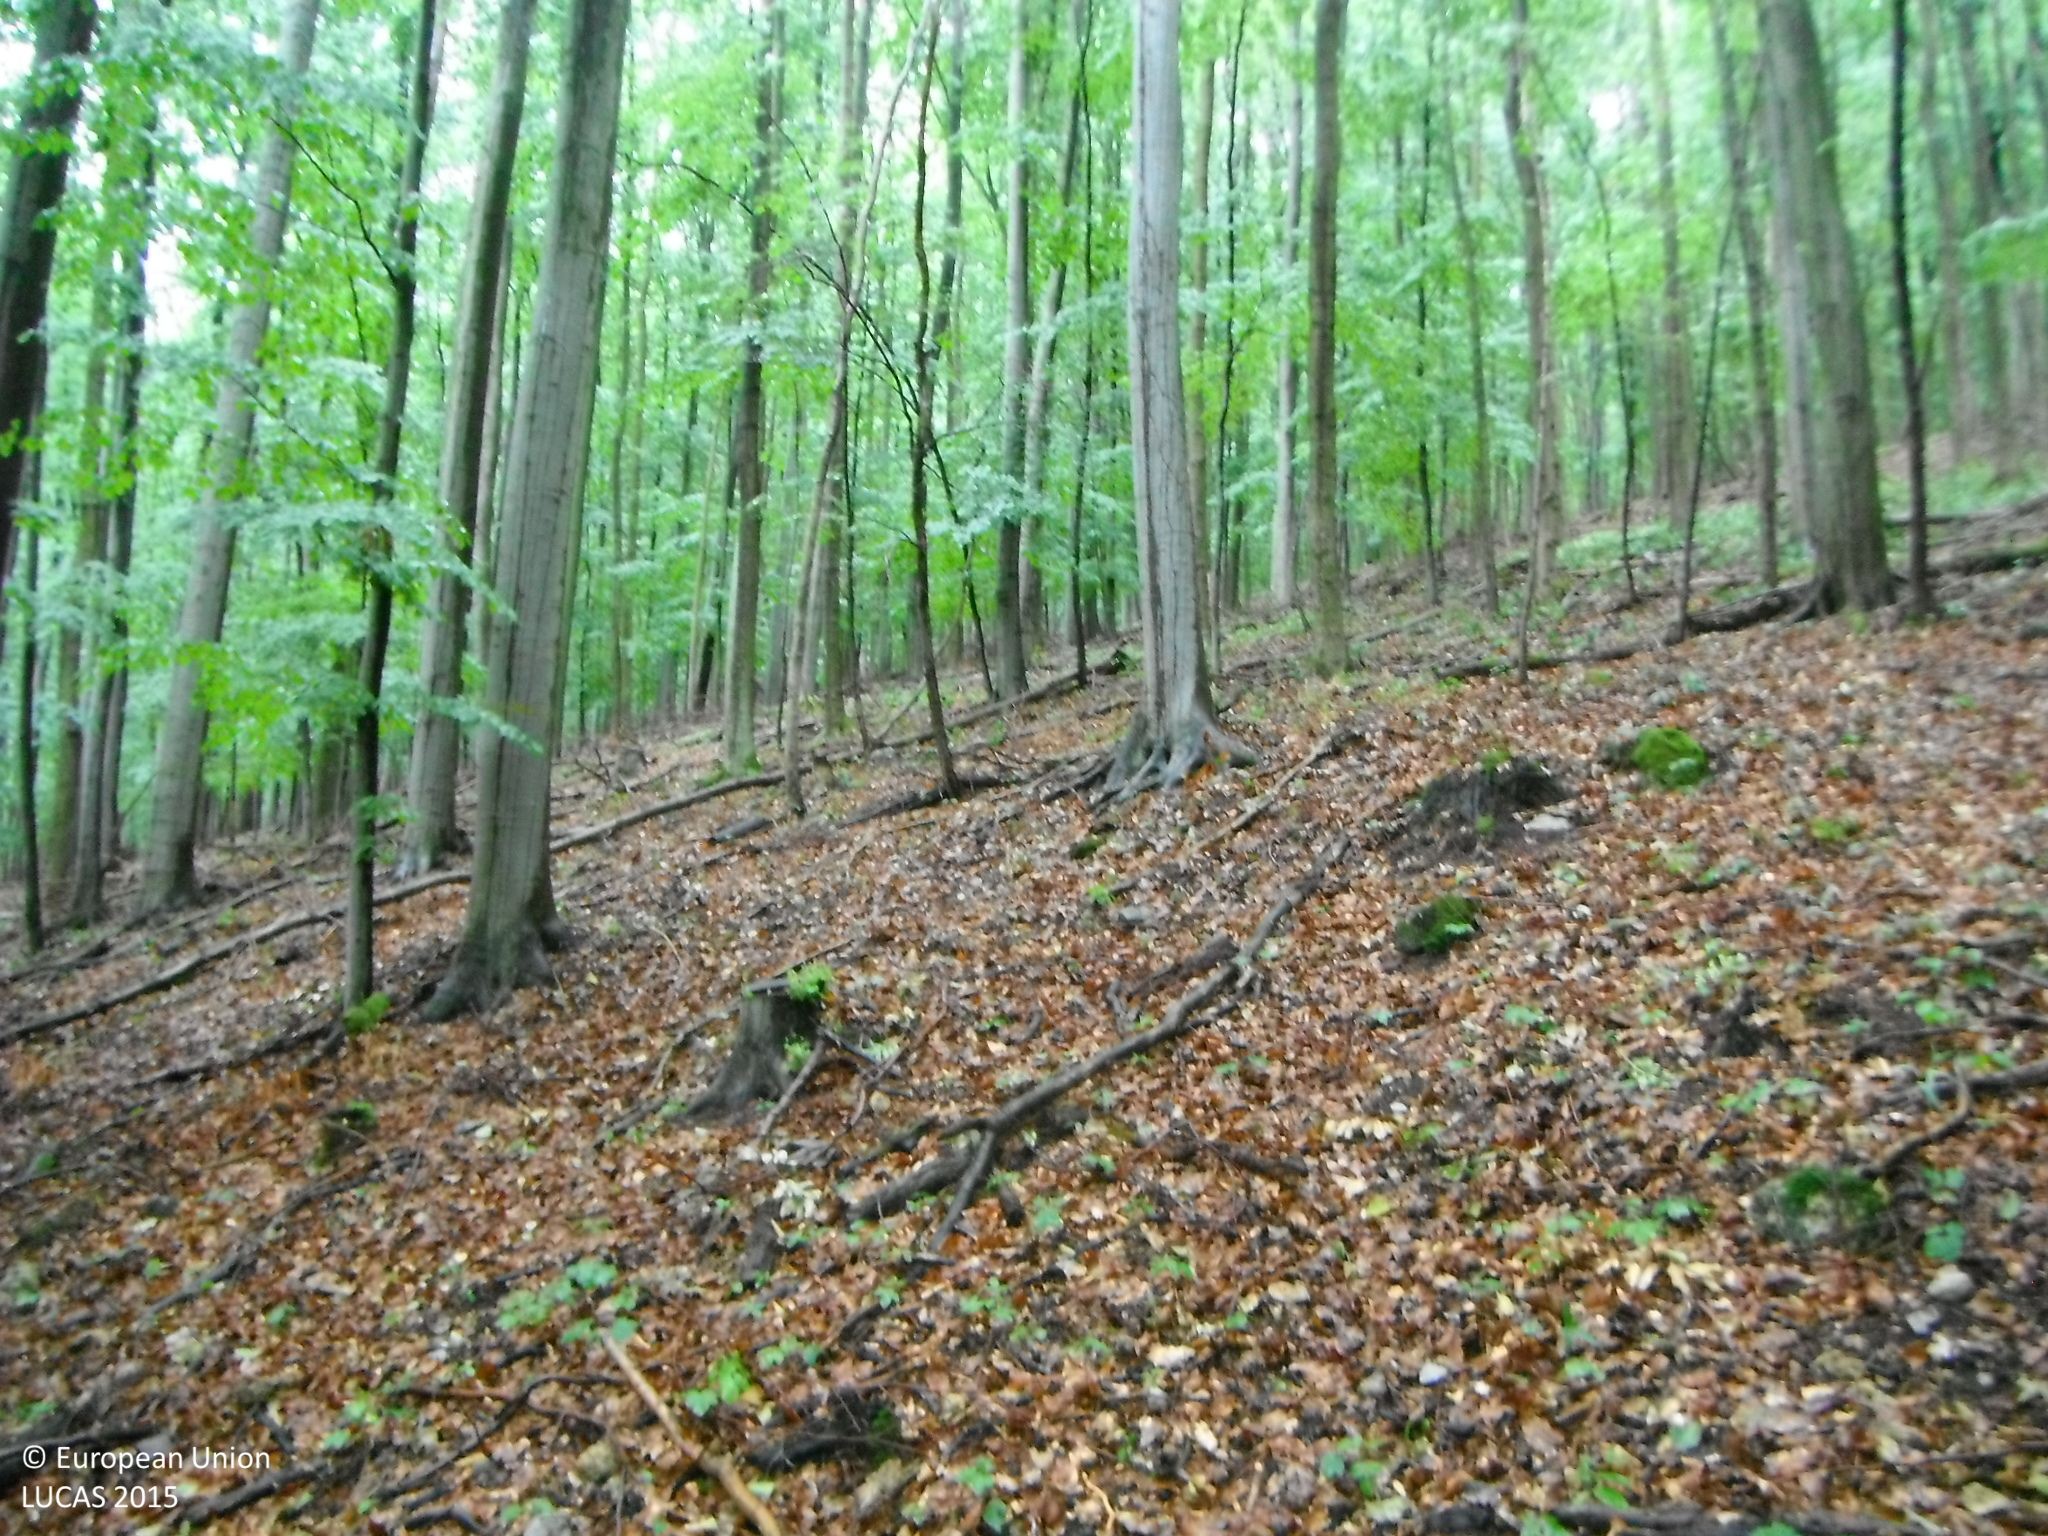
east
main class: Woodland
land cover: Broadleaved woodland
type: beech forest
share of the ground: > 75 %
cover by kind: broadleaved forest trees 100 %
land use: Forestry
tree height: > 5 m
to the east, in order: Broadleaved woodland
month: July
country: SK
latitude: 48.7820
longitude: 18.0028
